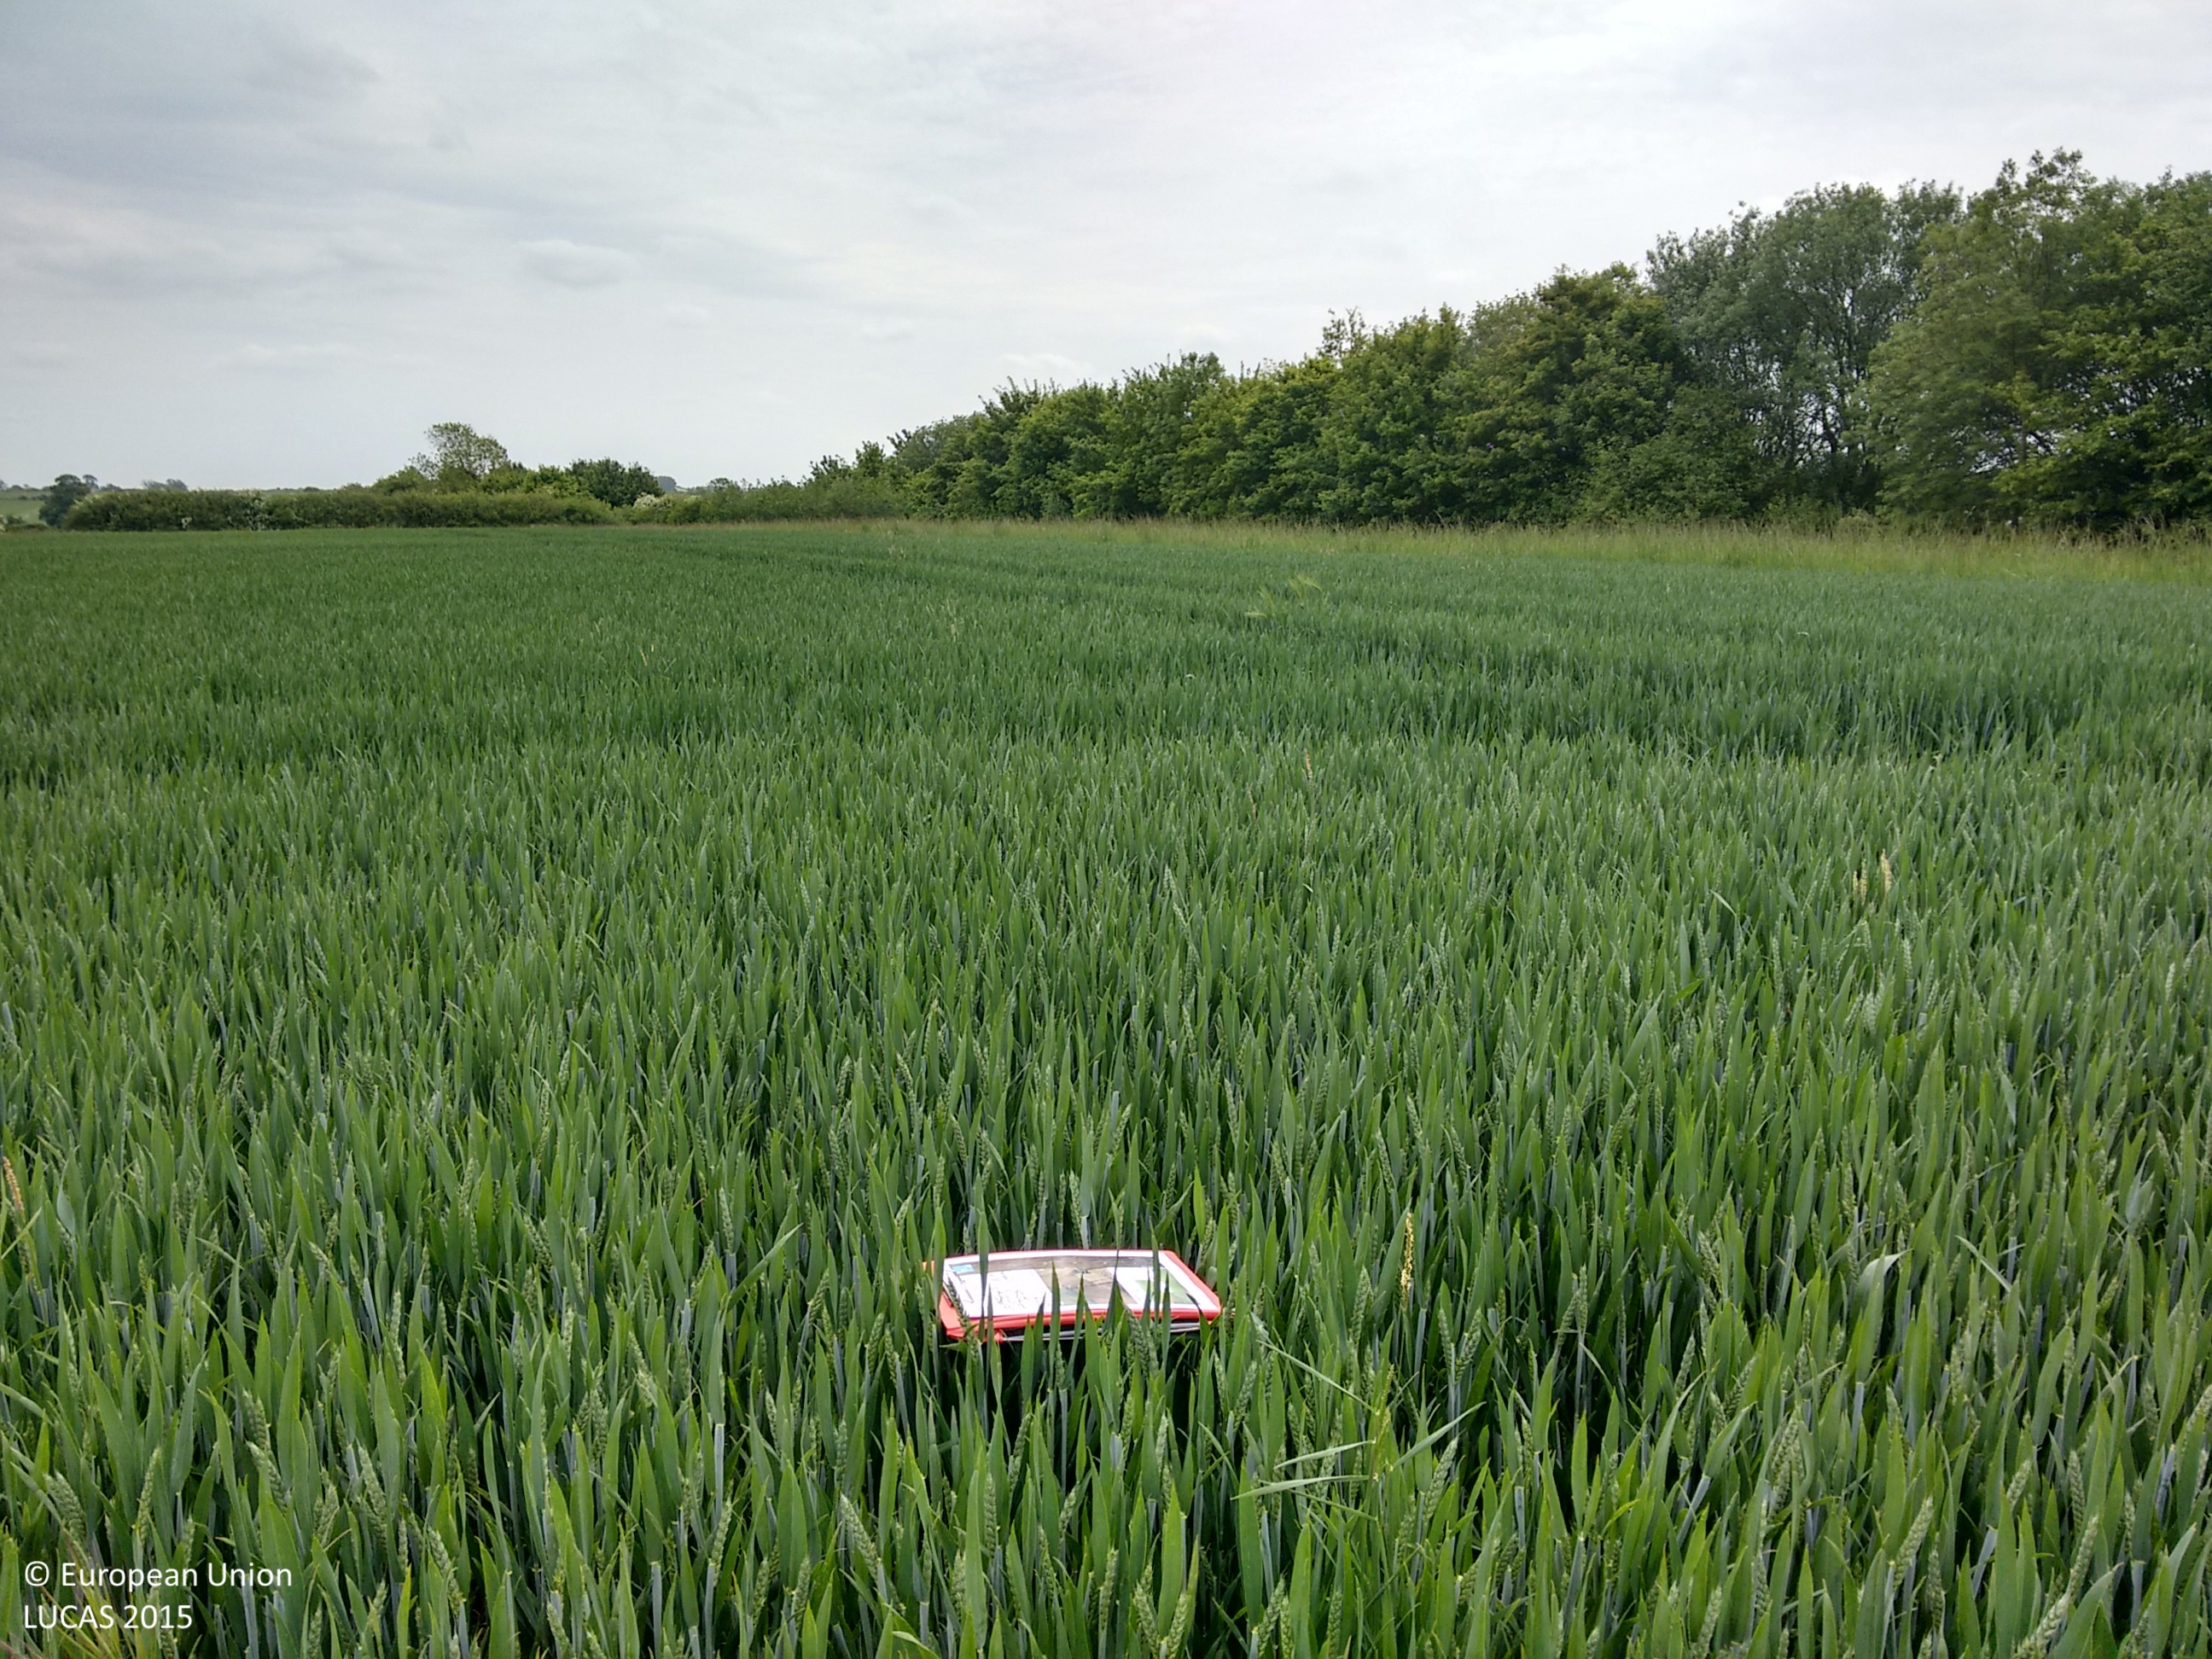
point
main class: Cropland
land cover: Common wheat
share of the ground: > 75 %
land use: Agriculture (excluding fallow land and kitchen gardens)
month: May
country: GB
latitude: 52.8835
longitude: -0.3644
